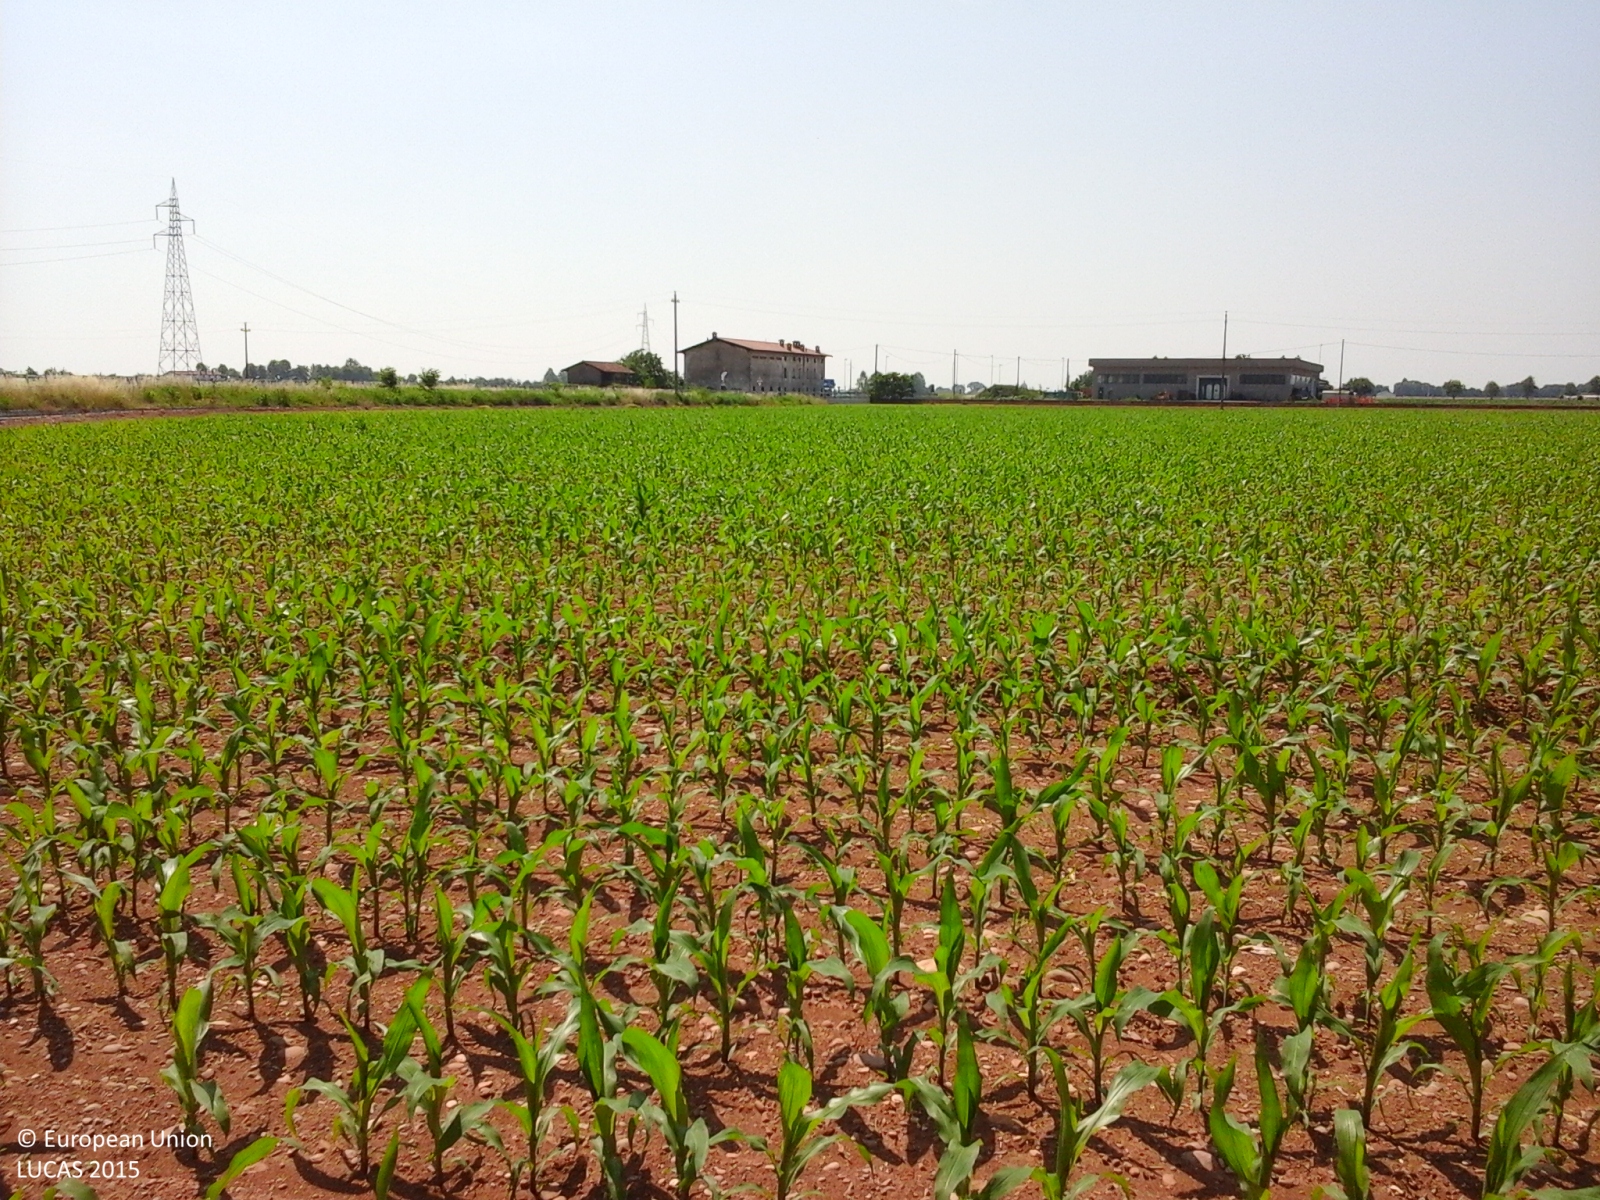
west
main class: Cropland
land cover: Maize
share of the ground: 50 - 75 %
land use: Agriculture (excluding fallow land and kitchen gardens)
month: June
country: IT
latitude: 45.5044
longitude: 9.9106
